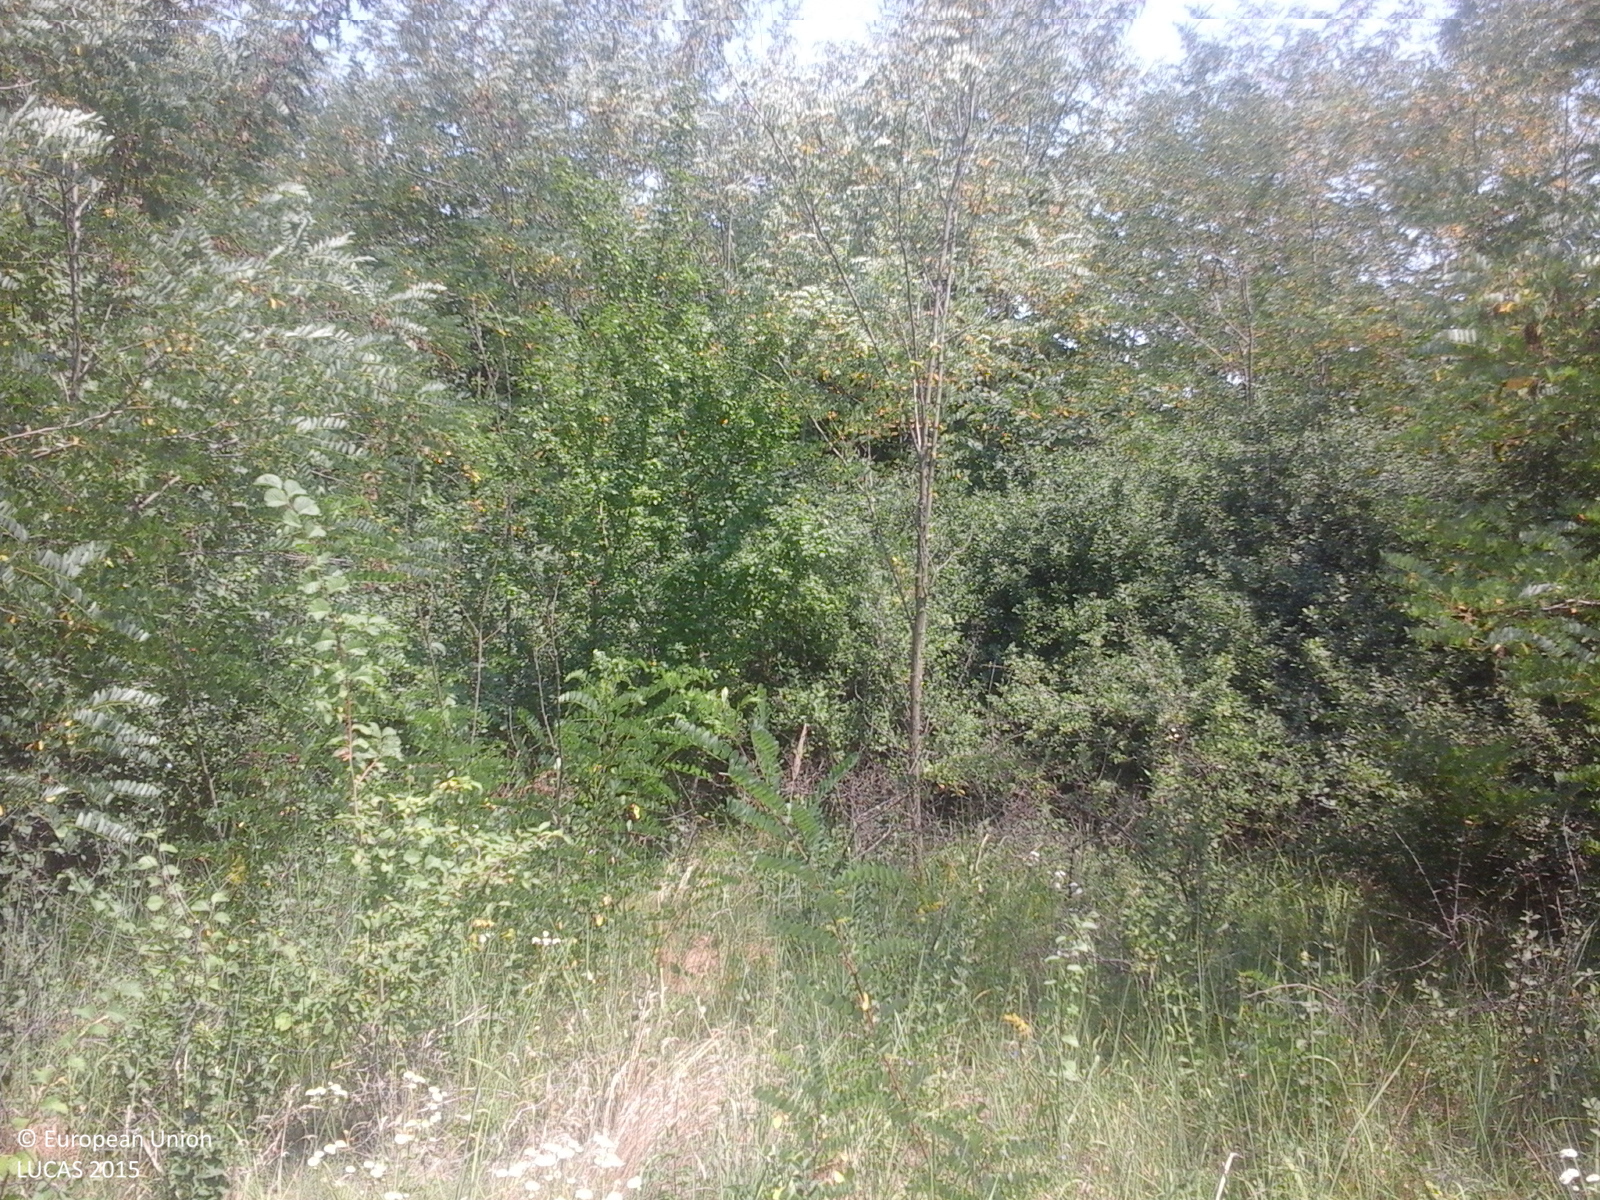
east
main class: Woodland
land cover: Broadleaved woodland
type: broadleaved evergreen forest
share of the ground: > 75 %
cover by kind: broadleaved forest trees 80 %, herbaceous plants 20 %
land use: Forestry
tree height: < 5 m
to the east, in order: Broadleaved woodland; Spontaneously vegetated surfaces; Ditches and canals; Spontaneously vegetated surfaces; Tracks; Broadleaved woodland; Oats; Spontaneously vegetated surfaces; Maize; Spontaneously vegetated surfaces; Abandoned hedges; Ditches and canals; Paved roads, cycling and walking lanes; Ditches and canals; Abandoned hedges; Grass margins; Common wheat
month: July
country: RO
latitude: 44.7490
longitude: 25.4135
